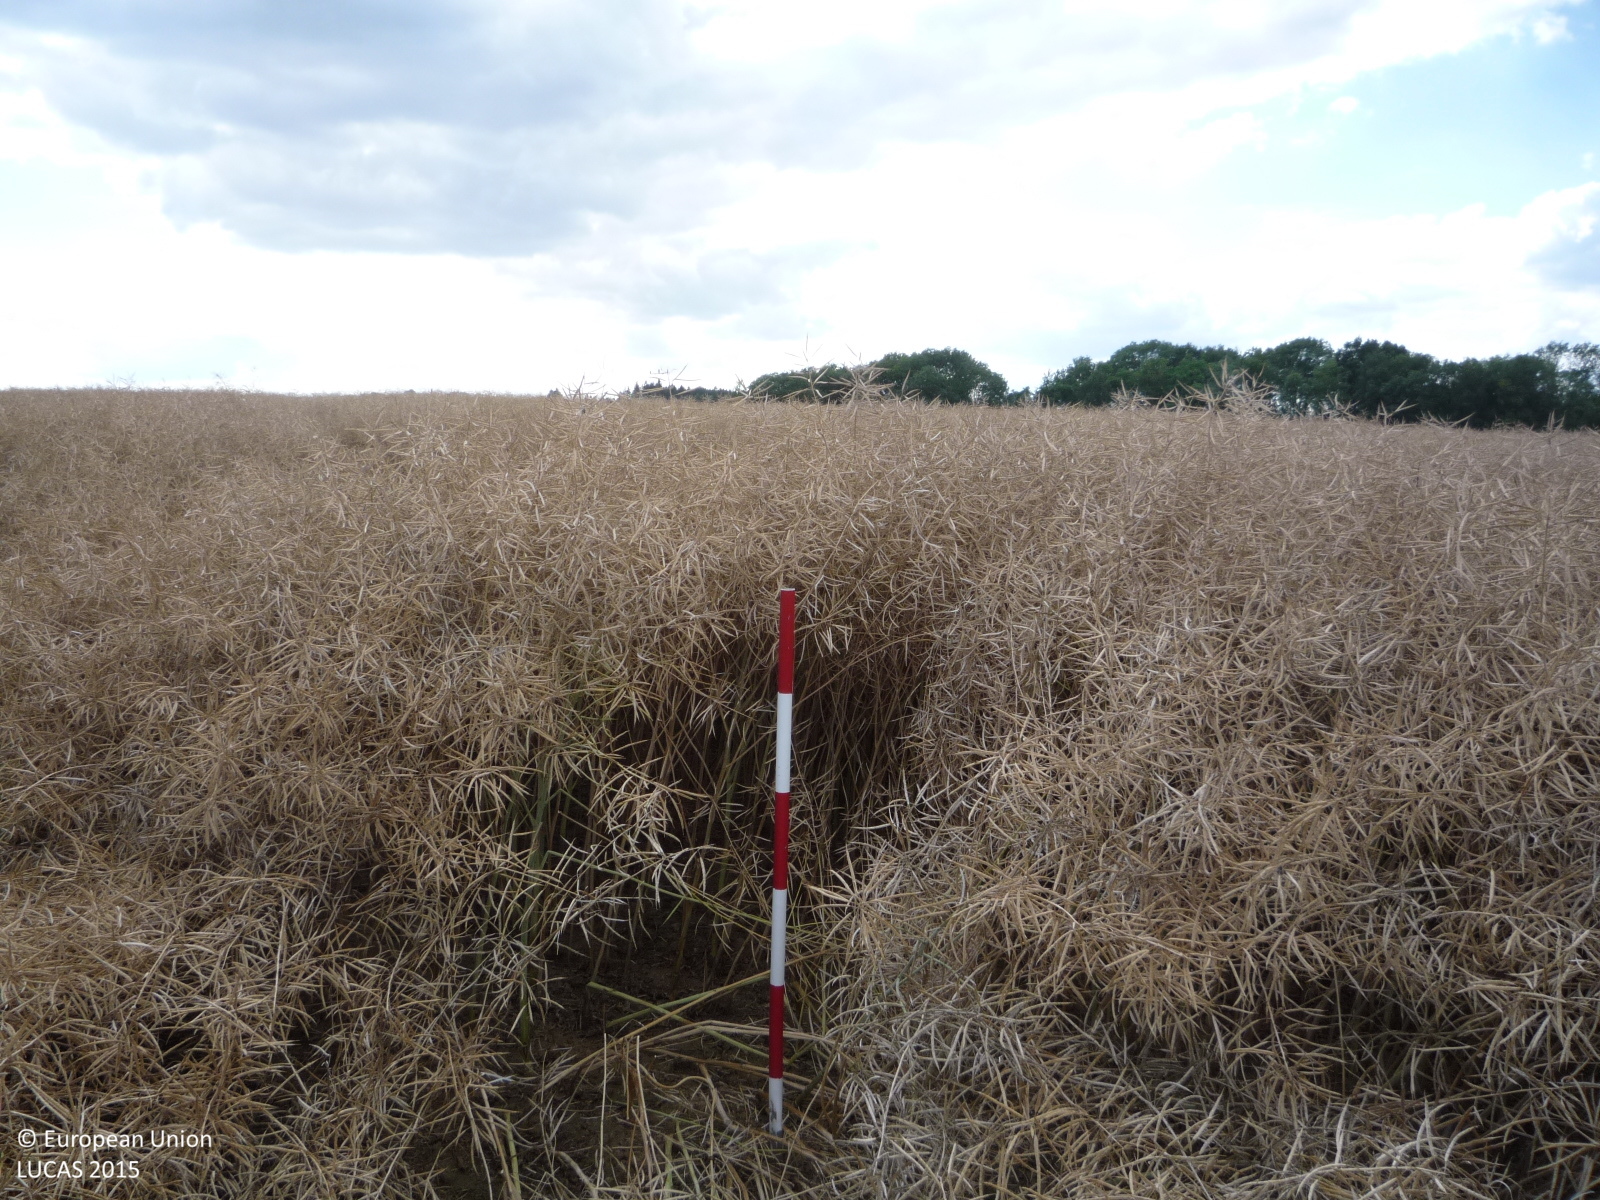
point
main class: Cropland
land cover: Rape and turnip rape
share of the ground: > 75 %
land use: Agriculture (excluding fallow land and kitchen gardens)
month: July
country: CZ
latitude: 50.4607
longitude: 15.2295
